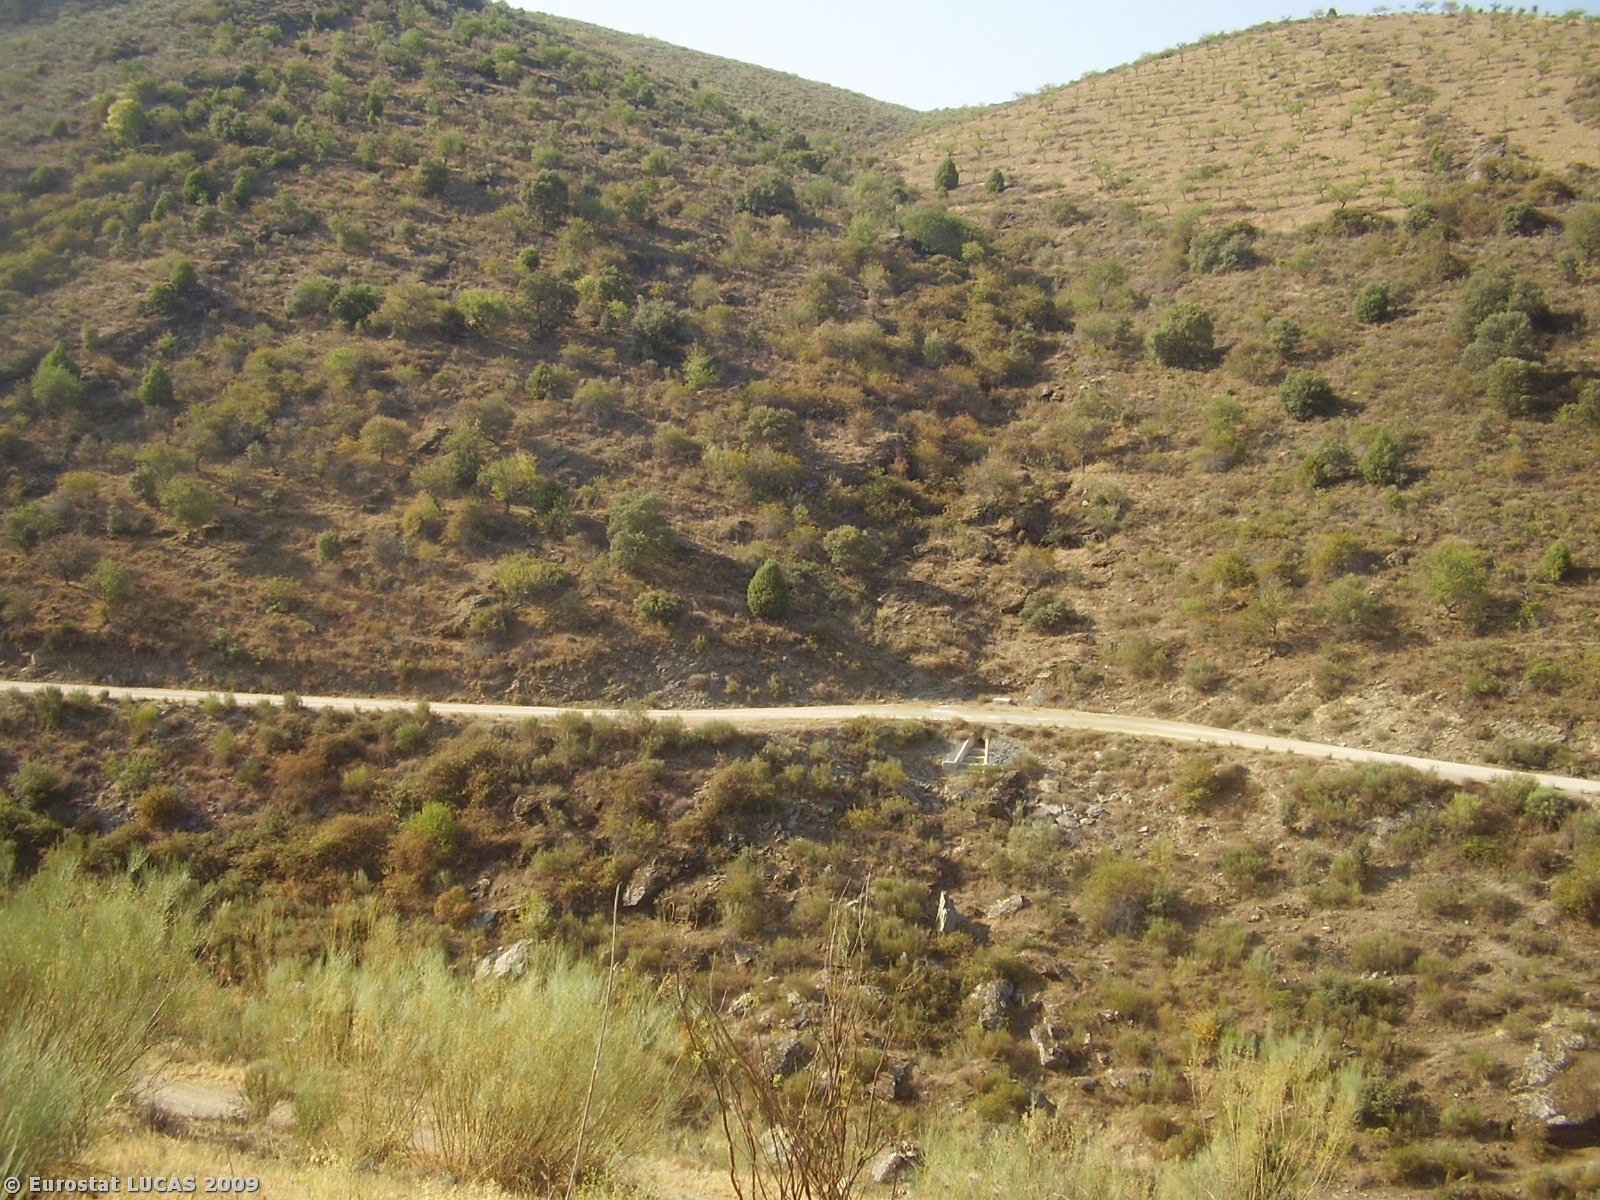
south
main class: Grassland
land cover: Spontaneously vegetated surfaces
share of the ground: > 75 %
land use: Fallow land
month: August
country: PT
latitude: 41.3301
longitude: -7.0193
